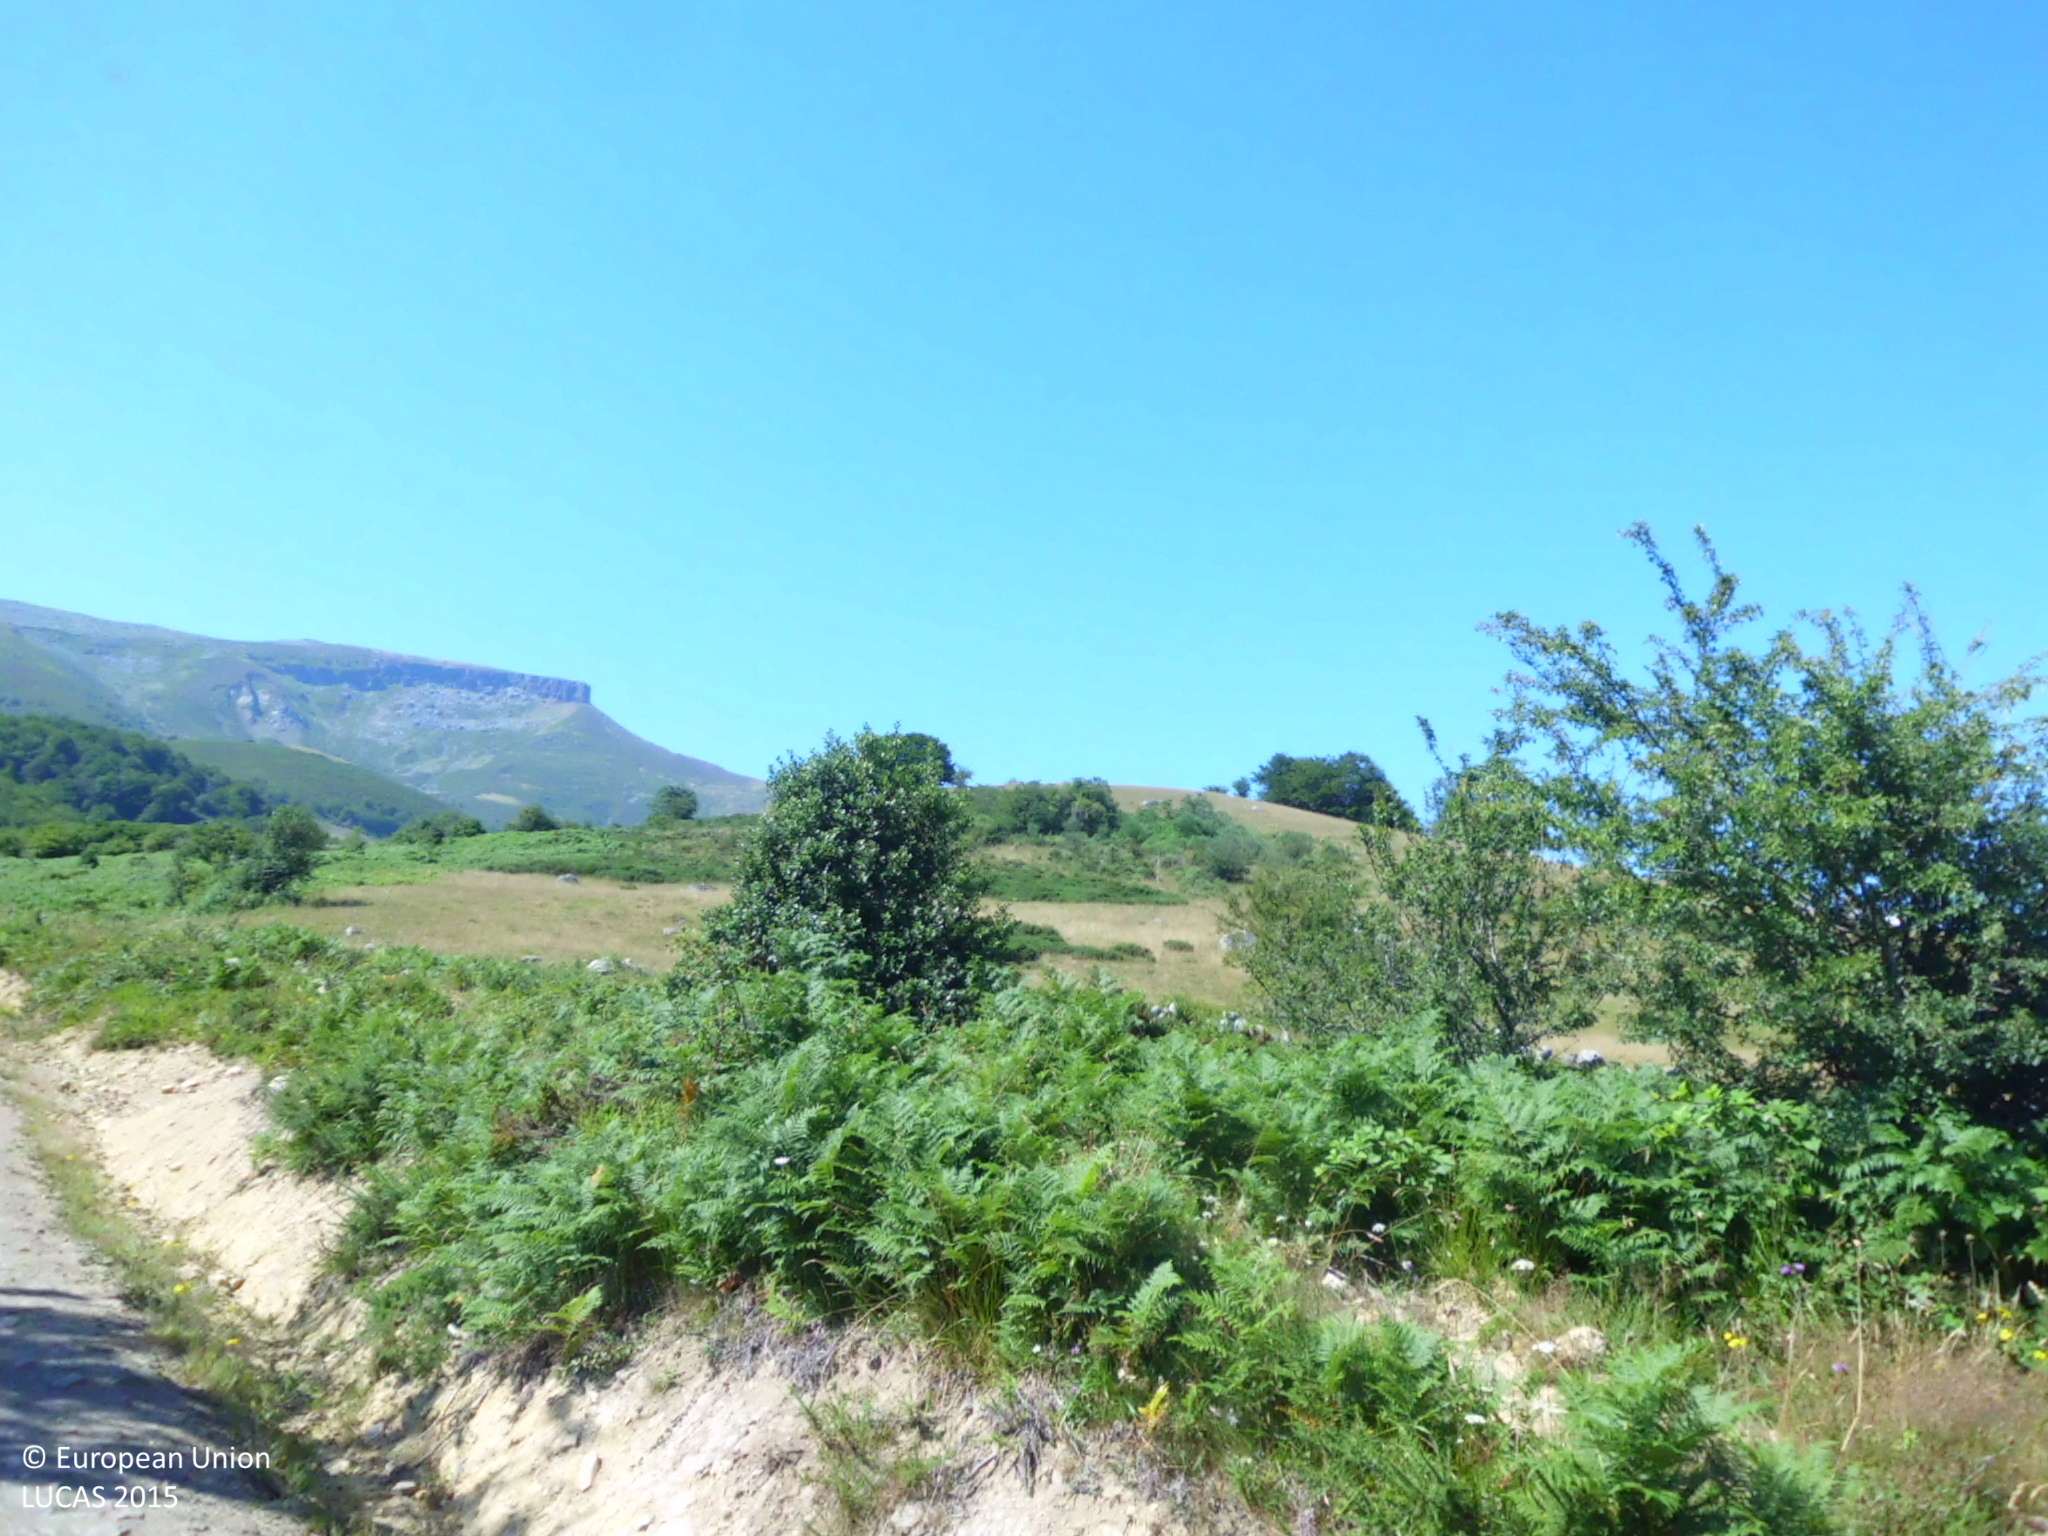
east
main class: Woodland
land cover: Broadleaved woodland
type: broadleaved evergreen forest
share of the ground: > 75 %
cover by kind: broadleaved forest trees 100 %
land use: Semi-natural and natural areas not in use
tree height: > 5 m
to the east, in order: Broadleaved woodland; Tracks; Broadleaved woodland
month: July
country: ES
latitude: 43.0640
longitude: -4.4103
